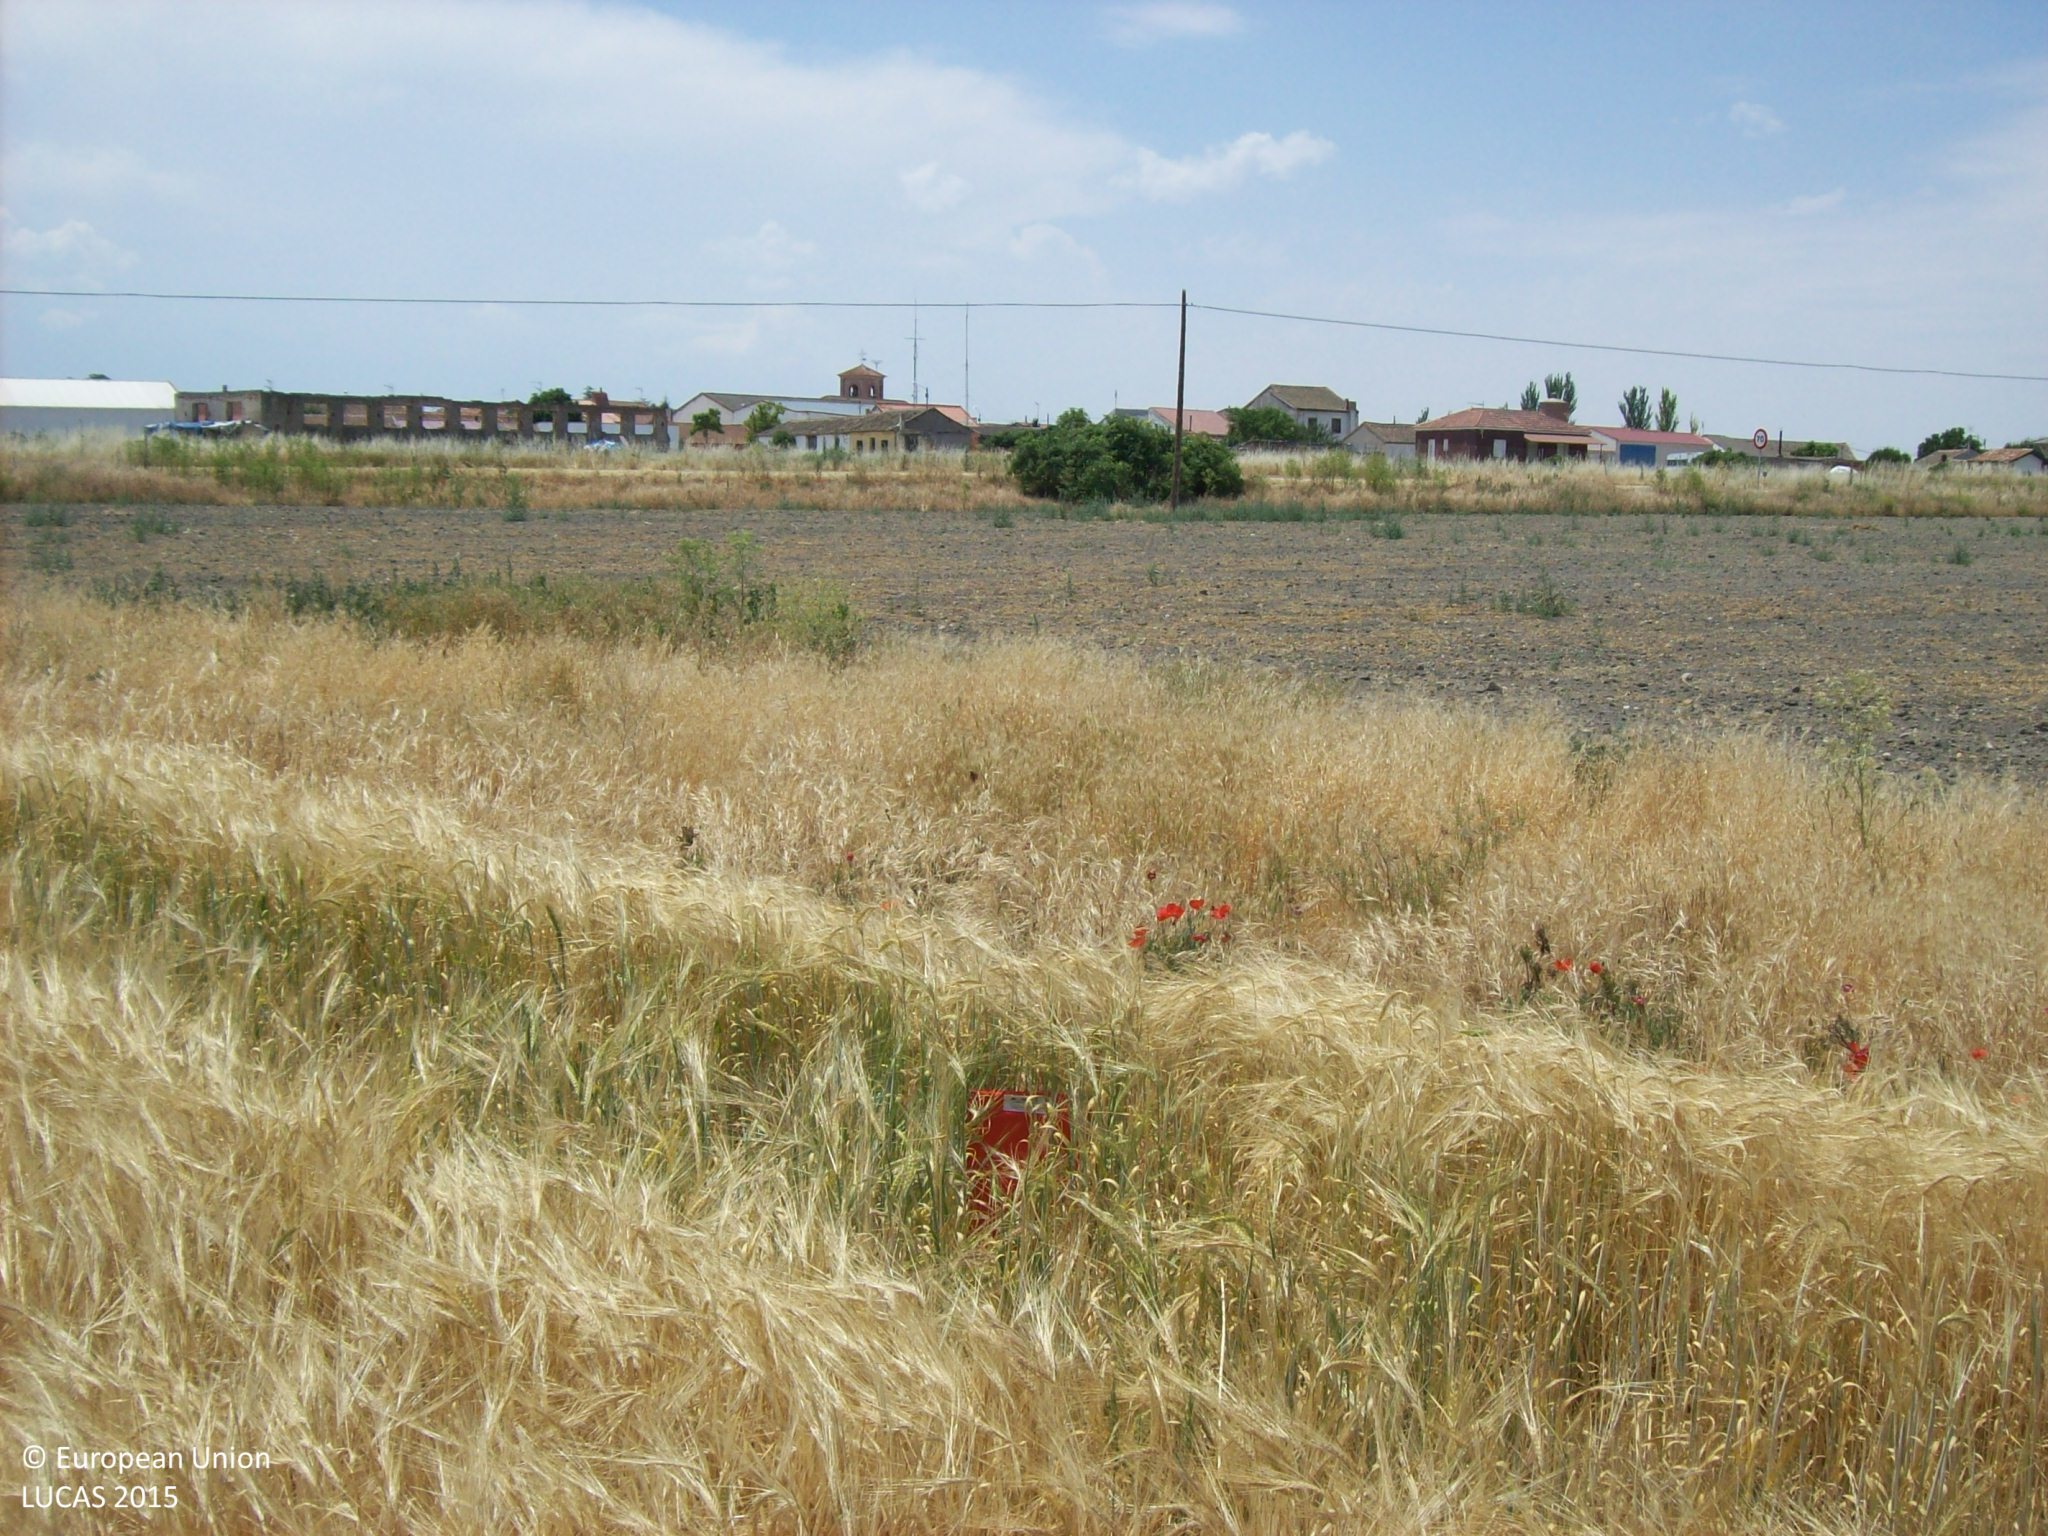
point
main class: Cropland
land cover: Barley
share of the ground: > 75 %
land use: Agriculture (excluding fallow land and kitchen gardens)
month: June
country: ES
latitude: 41.2261
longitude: -4.5792
